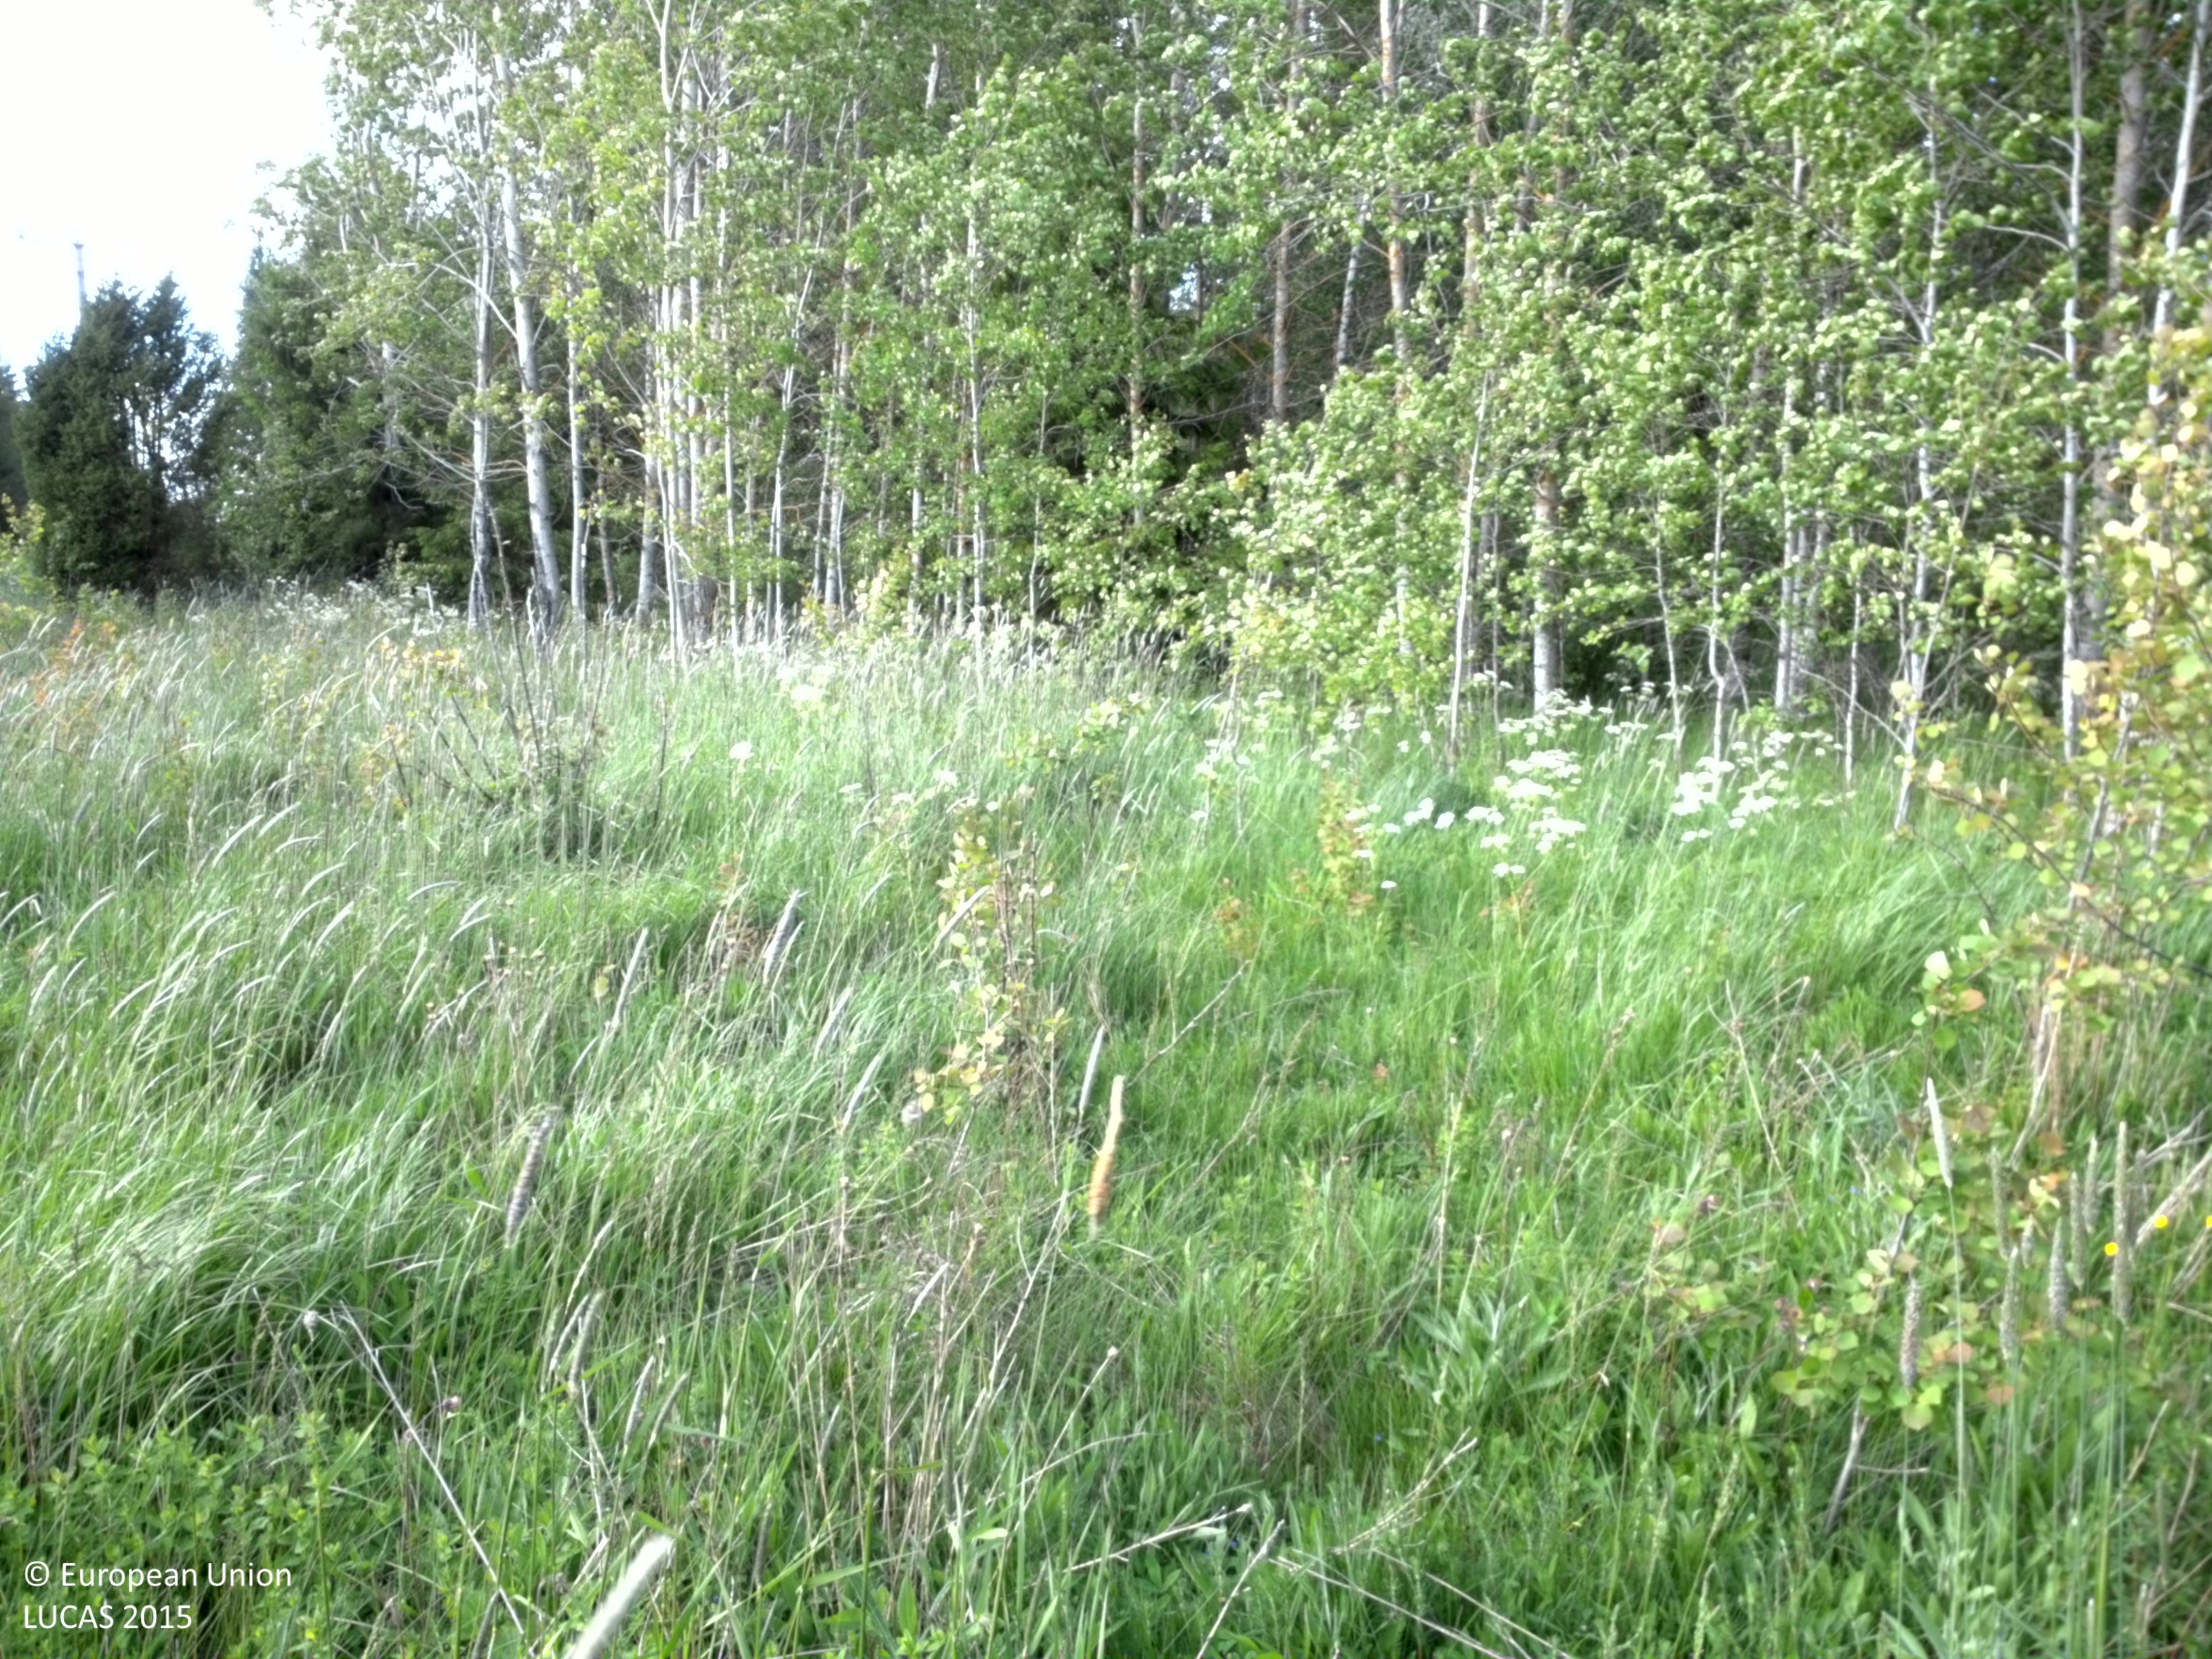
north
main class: Grassland
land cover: Grassland with sparse tree/shrub cover
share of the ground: > 75 %
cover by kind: herbaceous plants 95 %, broadleaved forest trees 5 %
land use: Semi-natural and natural areas not in use
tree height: > 5 m
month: June
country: SE
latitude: 58.3736
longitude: 16.4079
